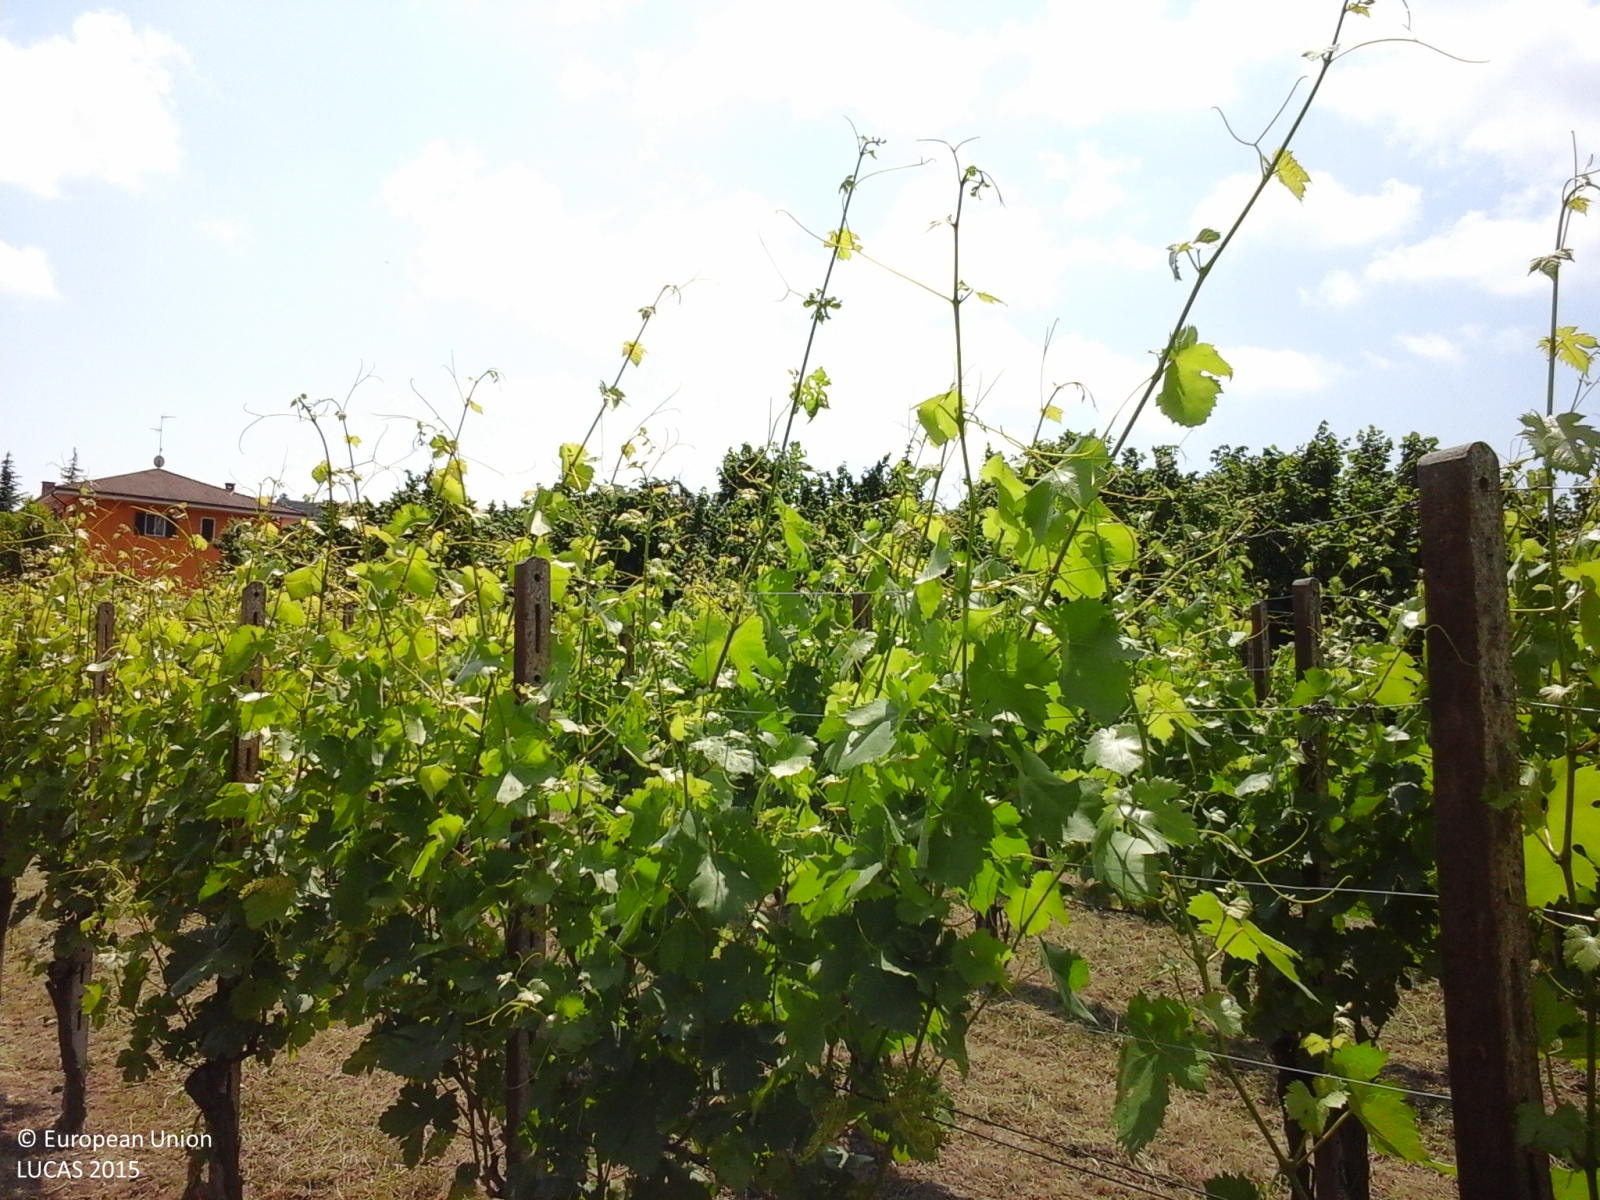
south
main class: Cropland
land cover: Vineyards
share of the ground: 25 - 50 %
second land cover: Grassland without tree/shrub cover
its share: > 75 %
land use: Agriculture (excluding fallow land and kitchen gardens)
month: May
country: IT
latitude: 44.7506
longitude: 8.2478
